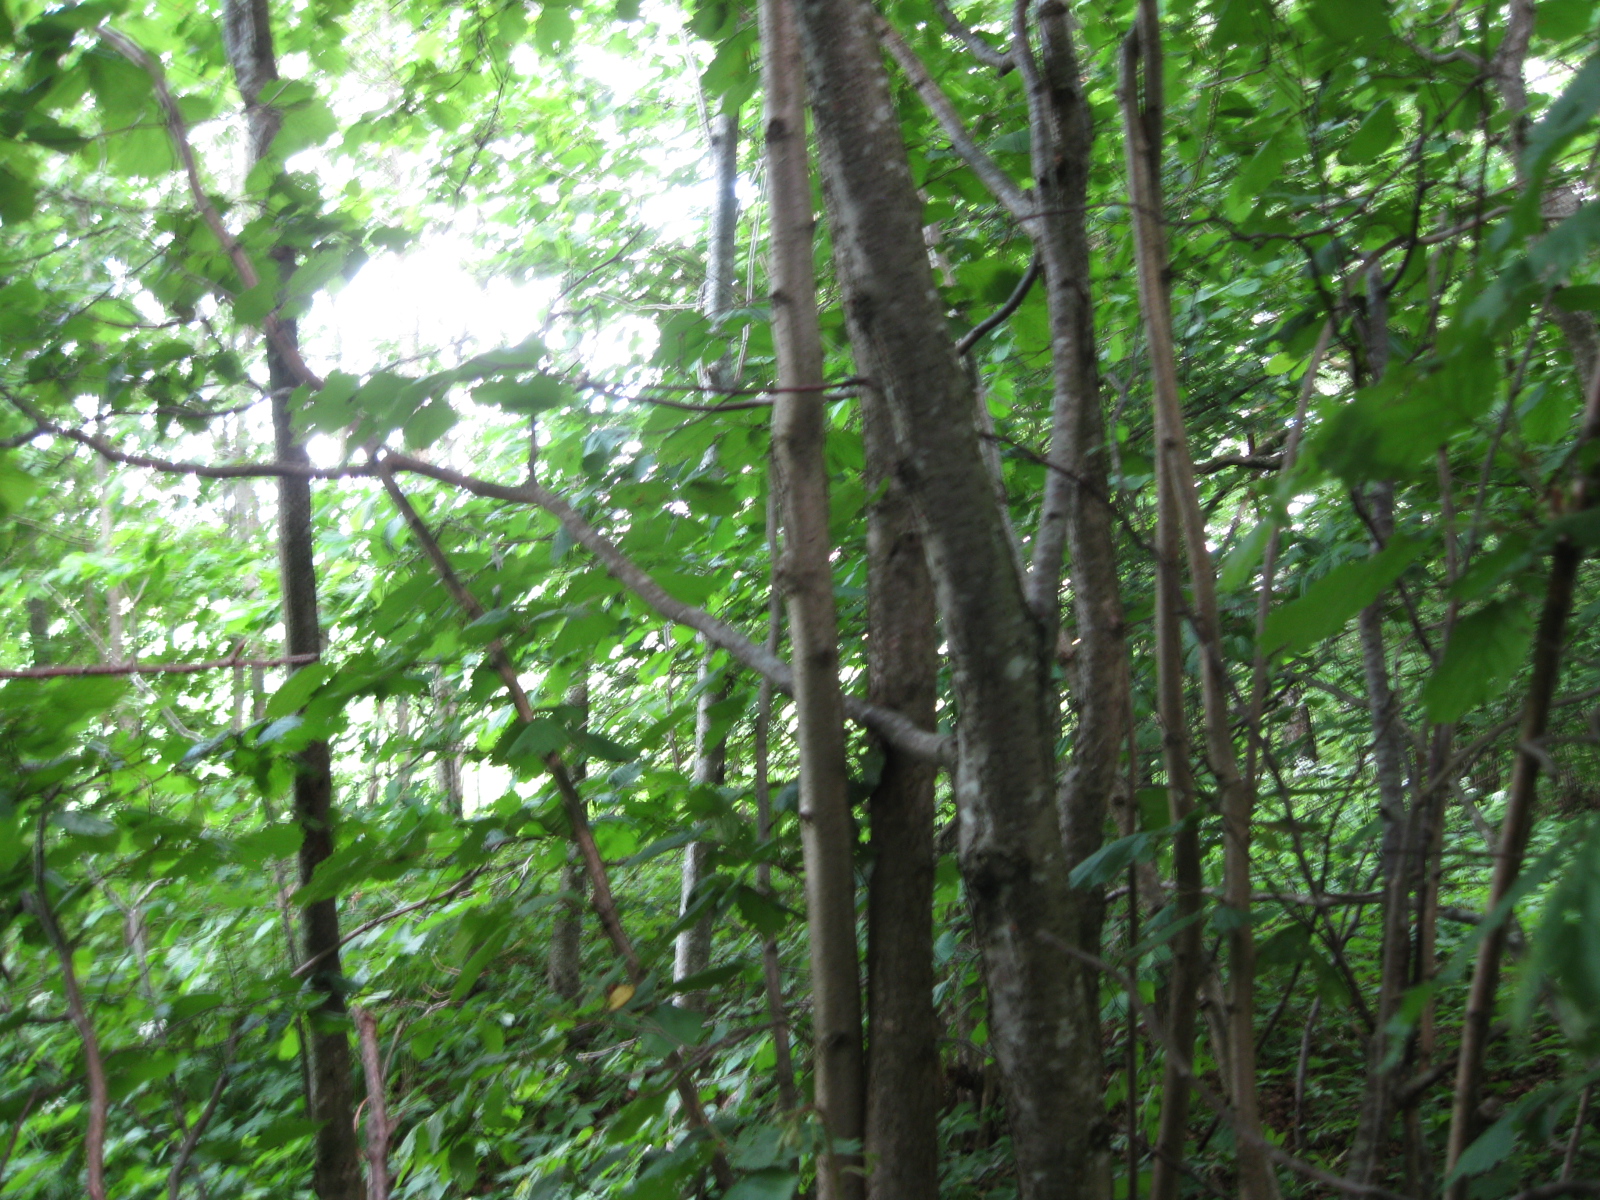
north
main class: Woodland
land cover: Broadleaved woodland
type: non-riverine alder, birch or aspen forest
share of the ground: > 75 %
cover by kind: broadleaved forest trees 90 %, shrubs 5 %, herbaceous plants 5 %
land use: Forestry
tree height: > 5 m
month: June
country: LT
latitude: 55.4776
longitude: 24.0934
